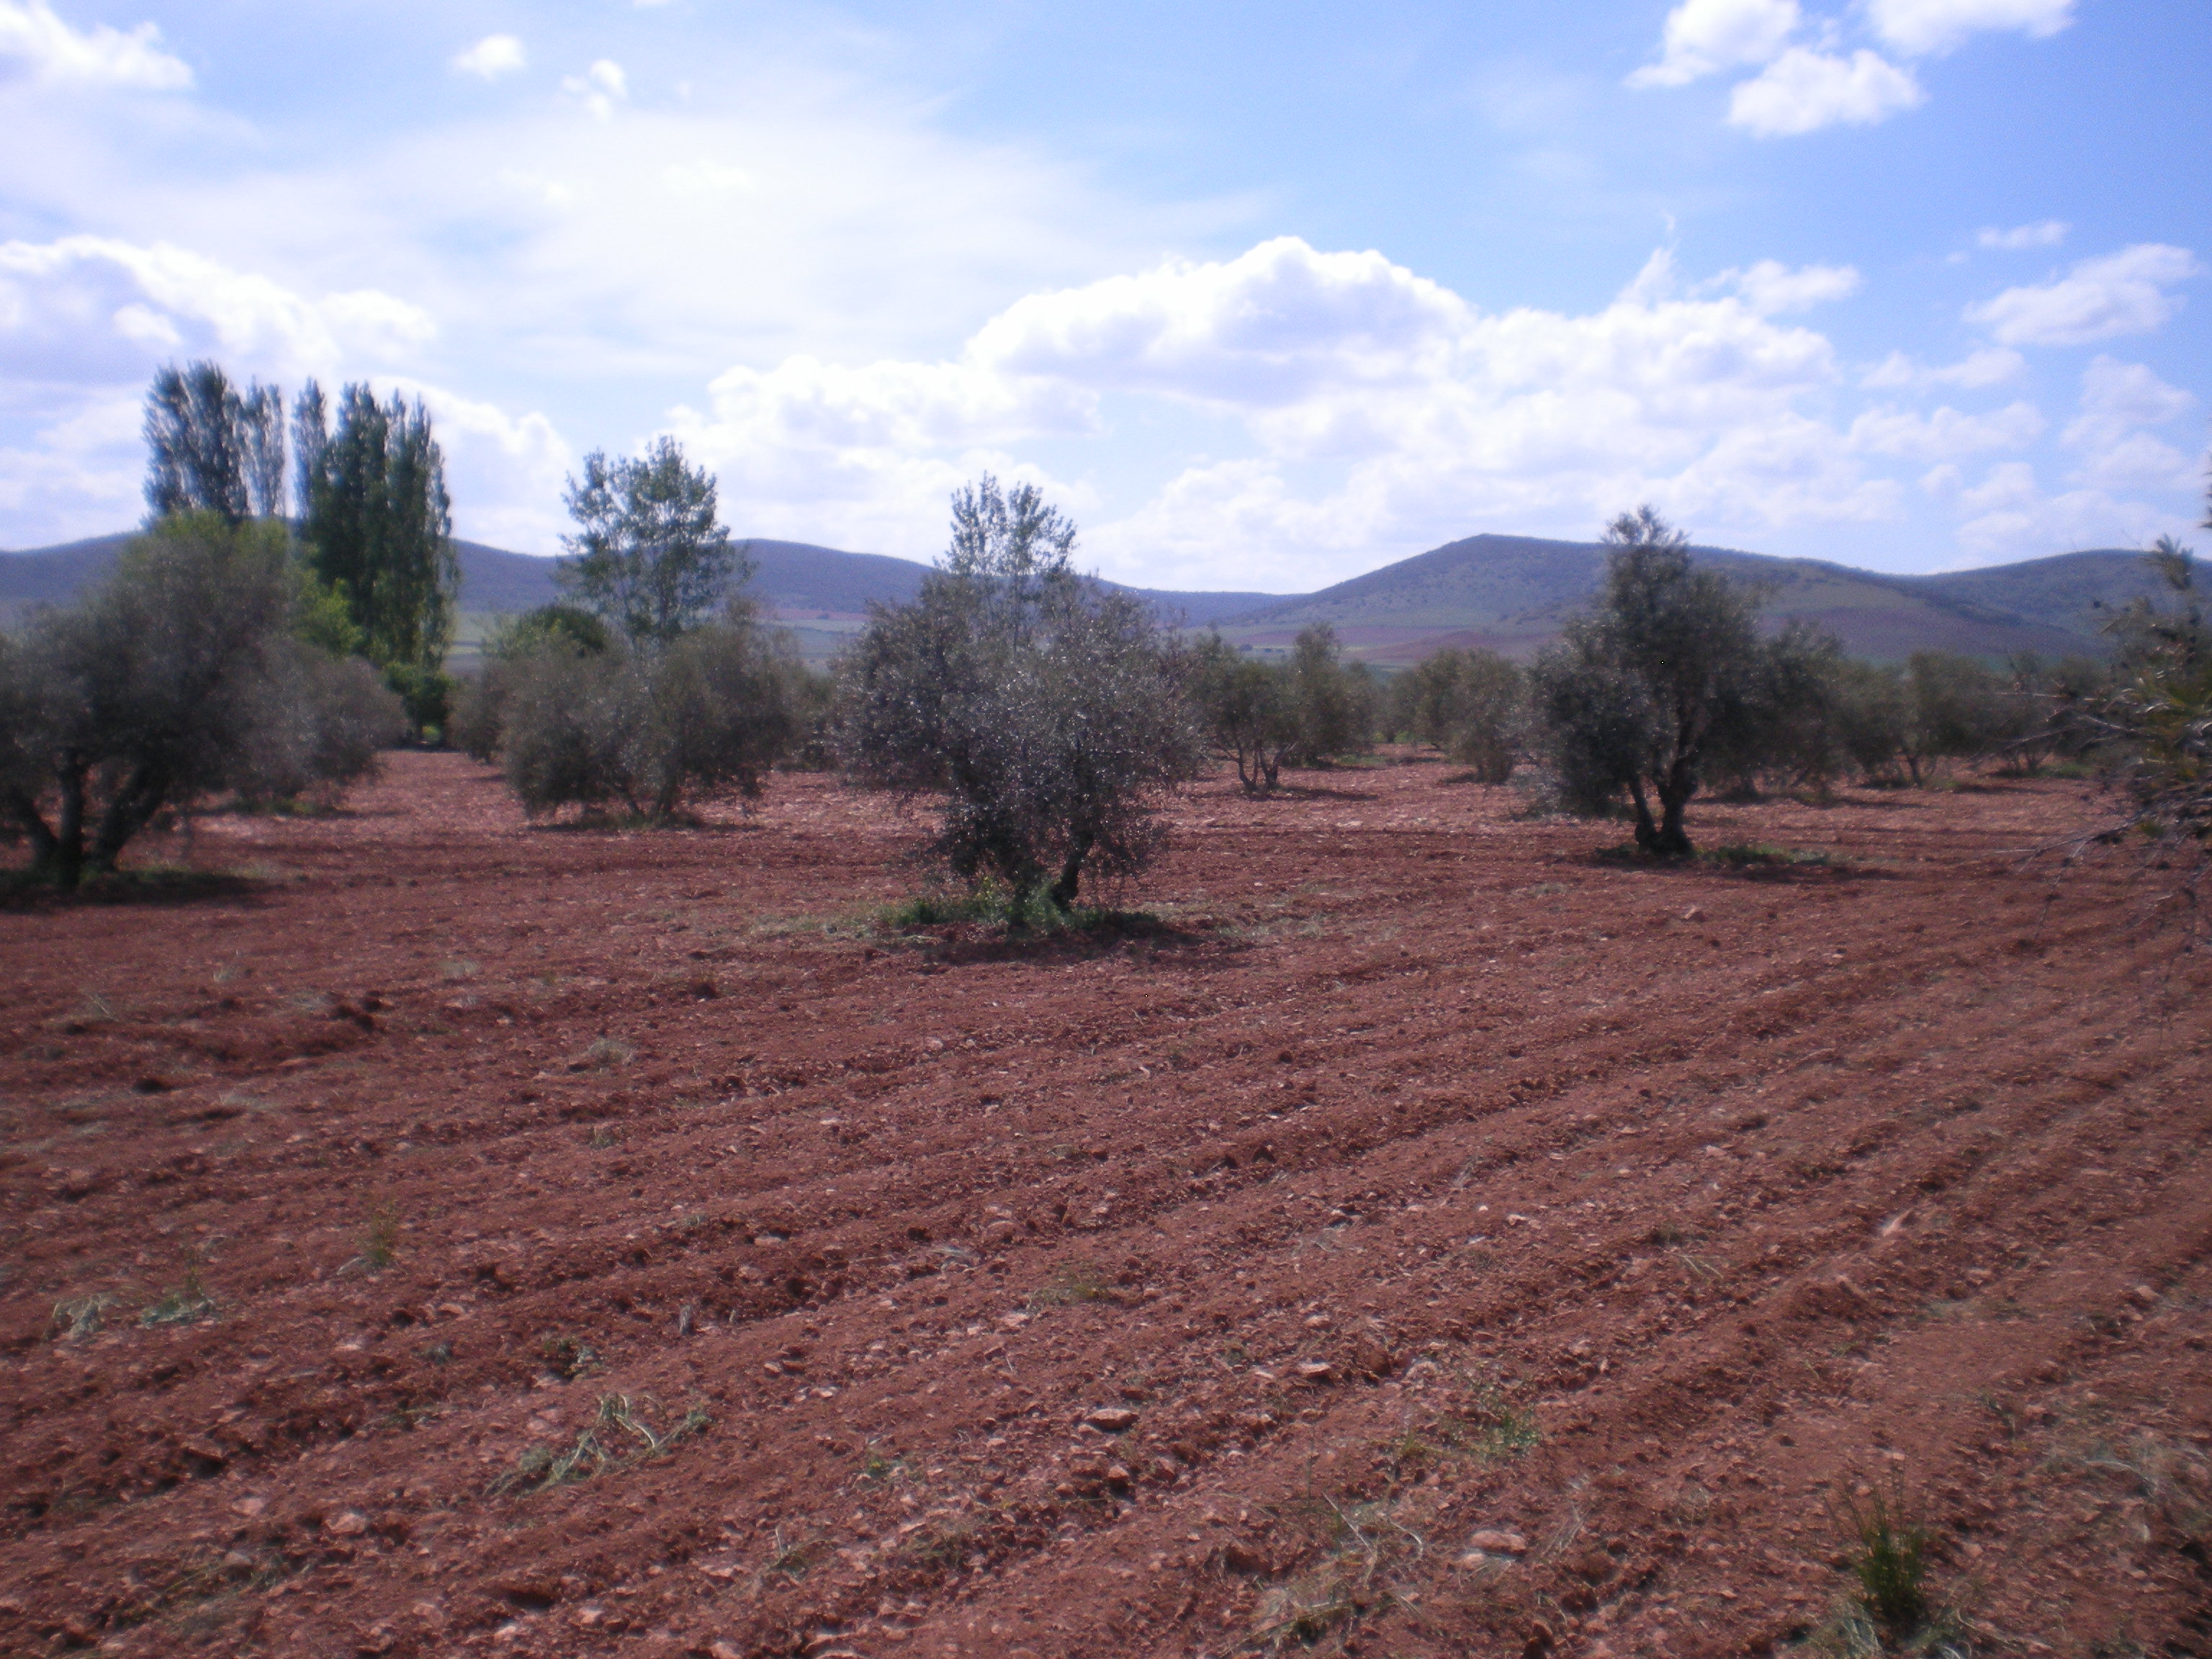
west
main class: Cropland
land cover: Olive groves
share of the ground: 10 - 25 %
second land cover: Other bare soil
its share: > 75 %
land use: Agriculture (excluding fallow land and kitchen gardens)
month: April
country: ES
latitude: 38.6676
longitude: -3.5154
